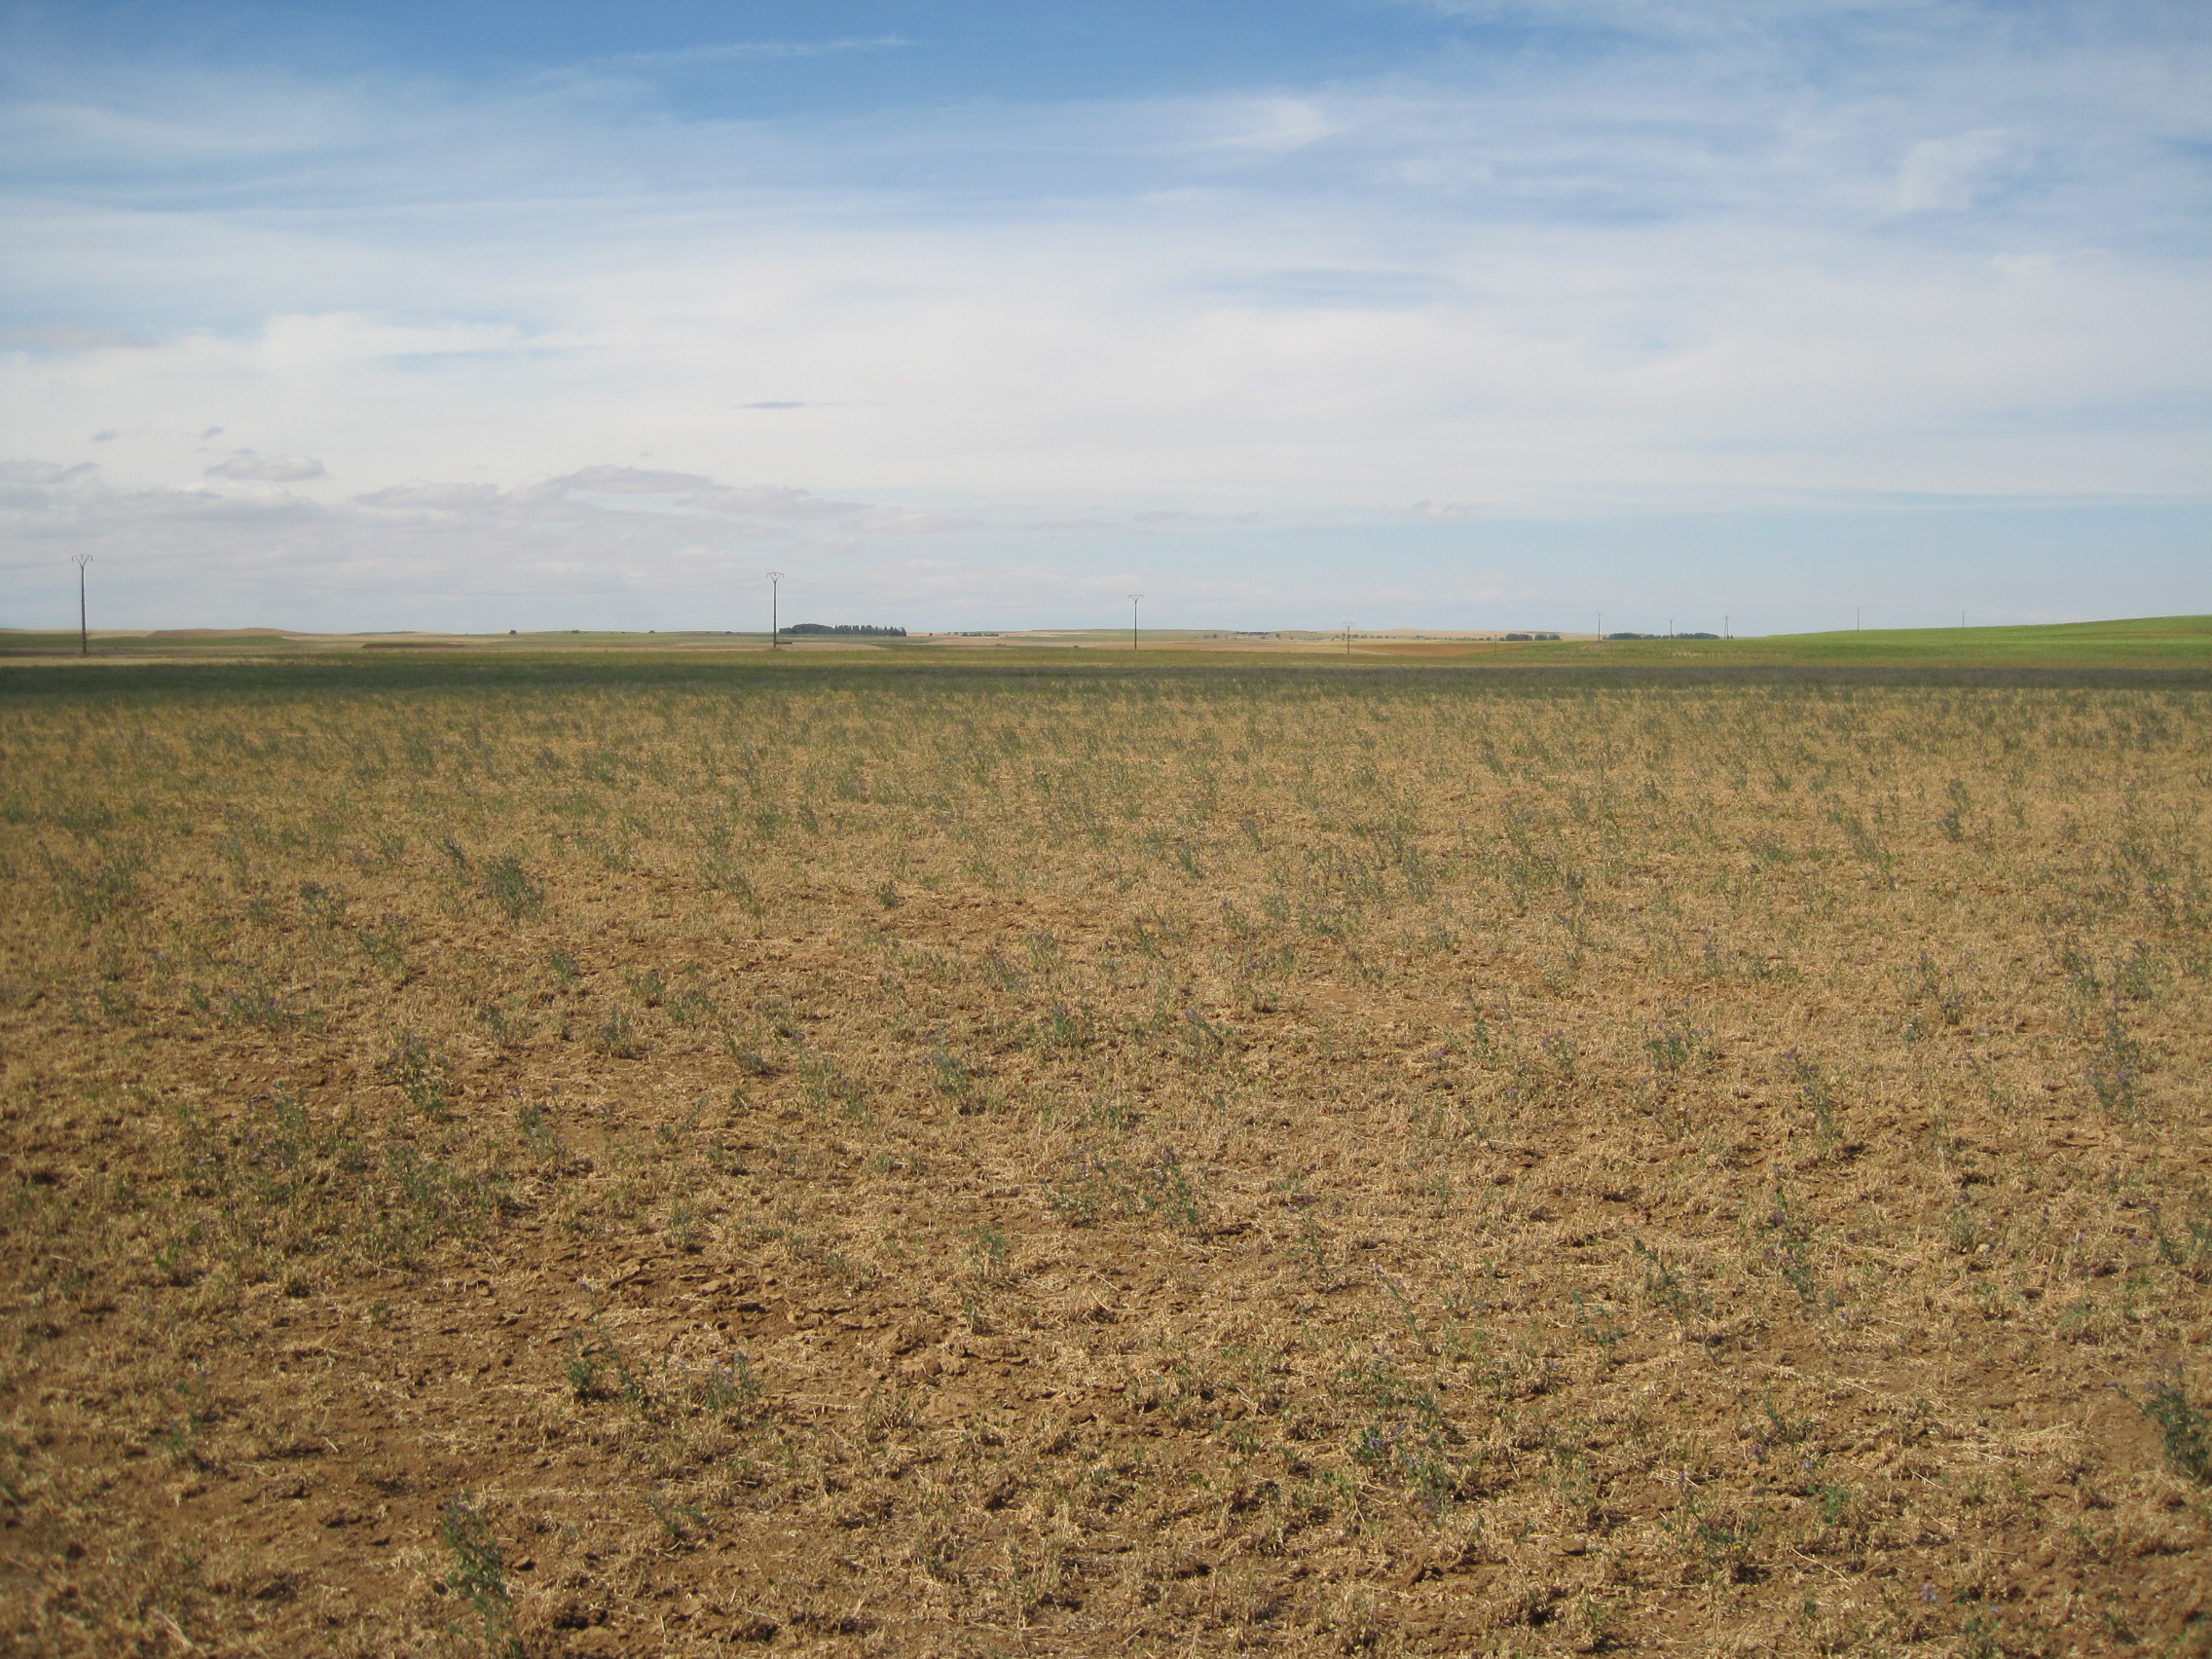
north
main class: Cropland
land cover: Lucerne
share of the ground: 25 - 50 %
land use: Agriculture (excluding fallow land and kitchen gardens)
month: July
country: ES
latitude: 41.9579
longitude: -5.1989
